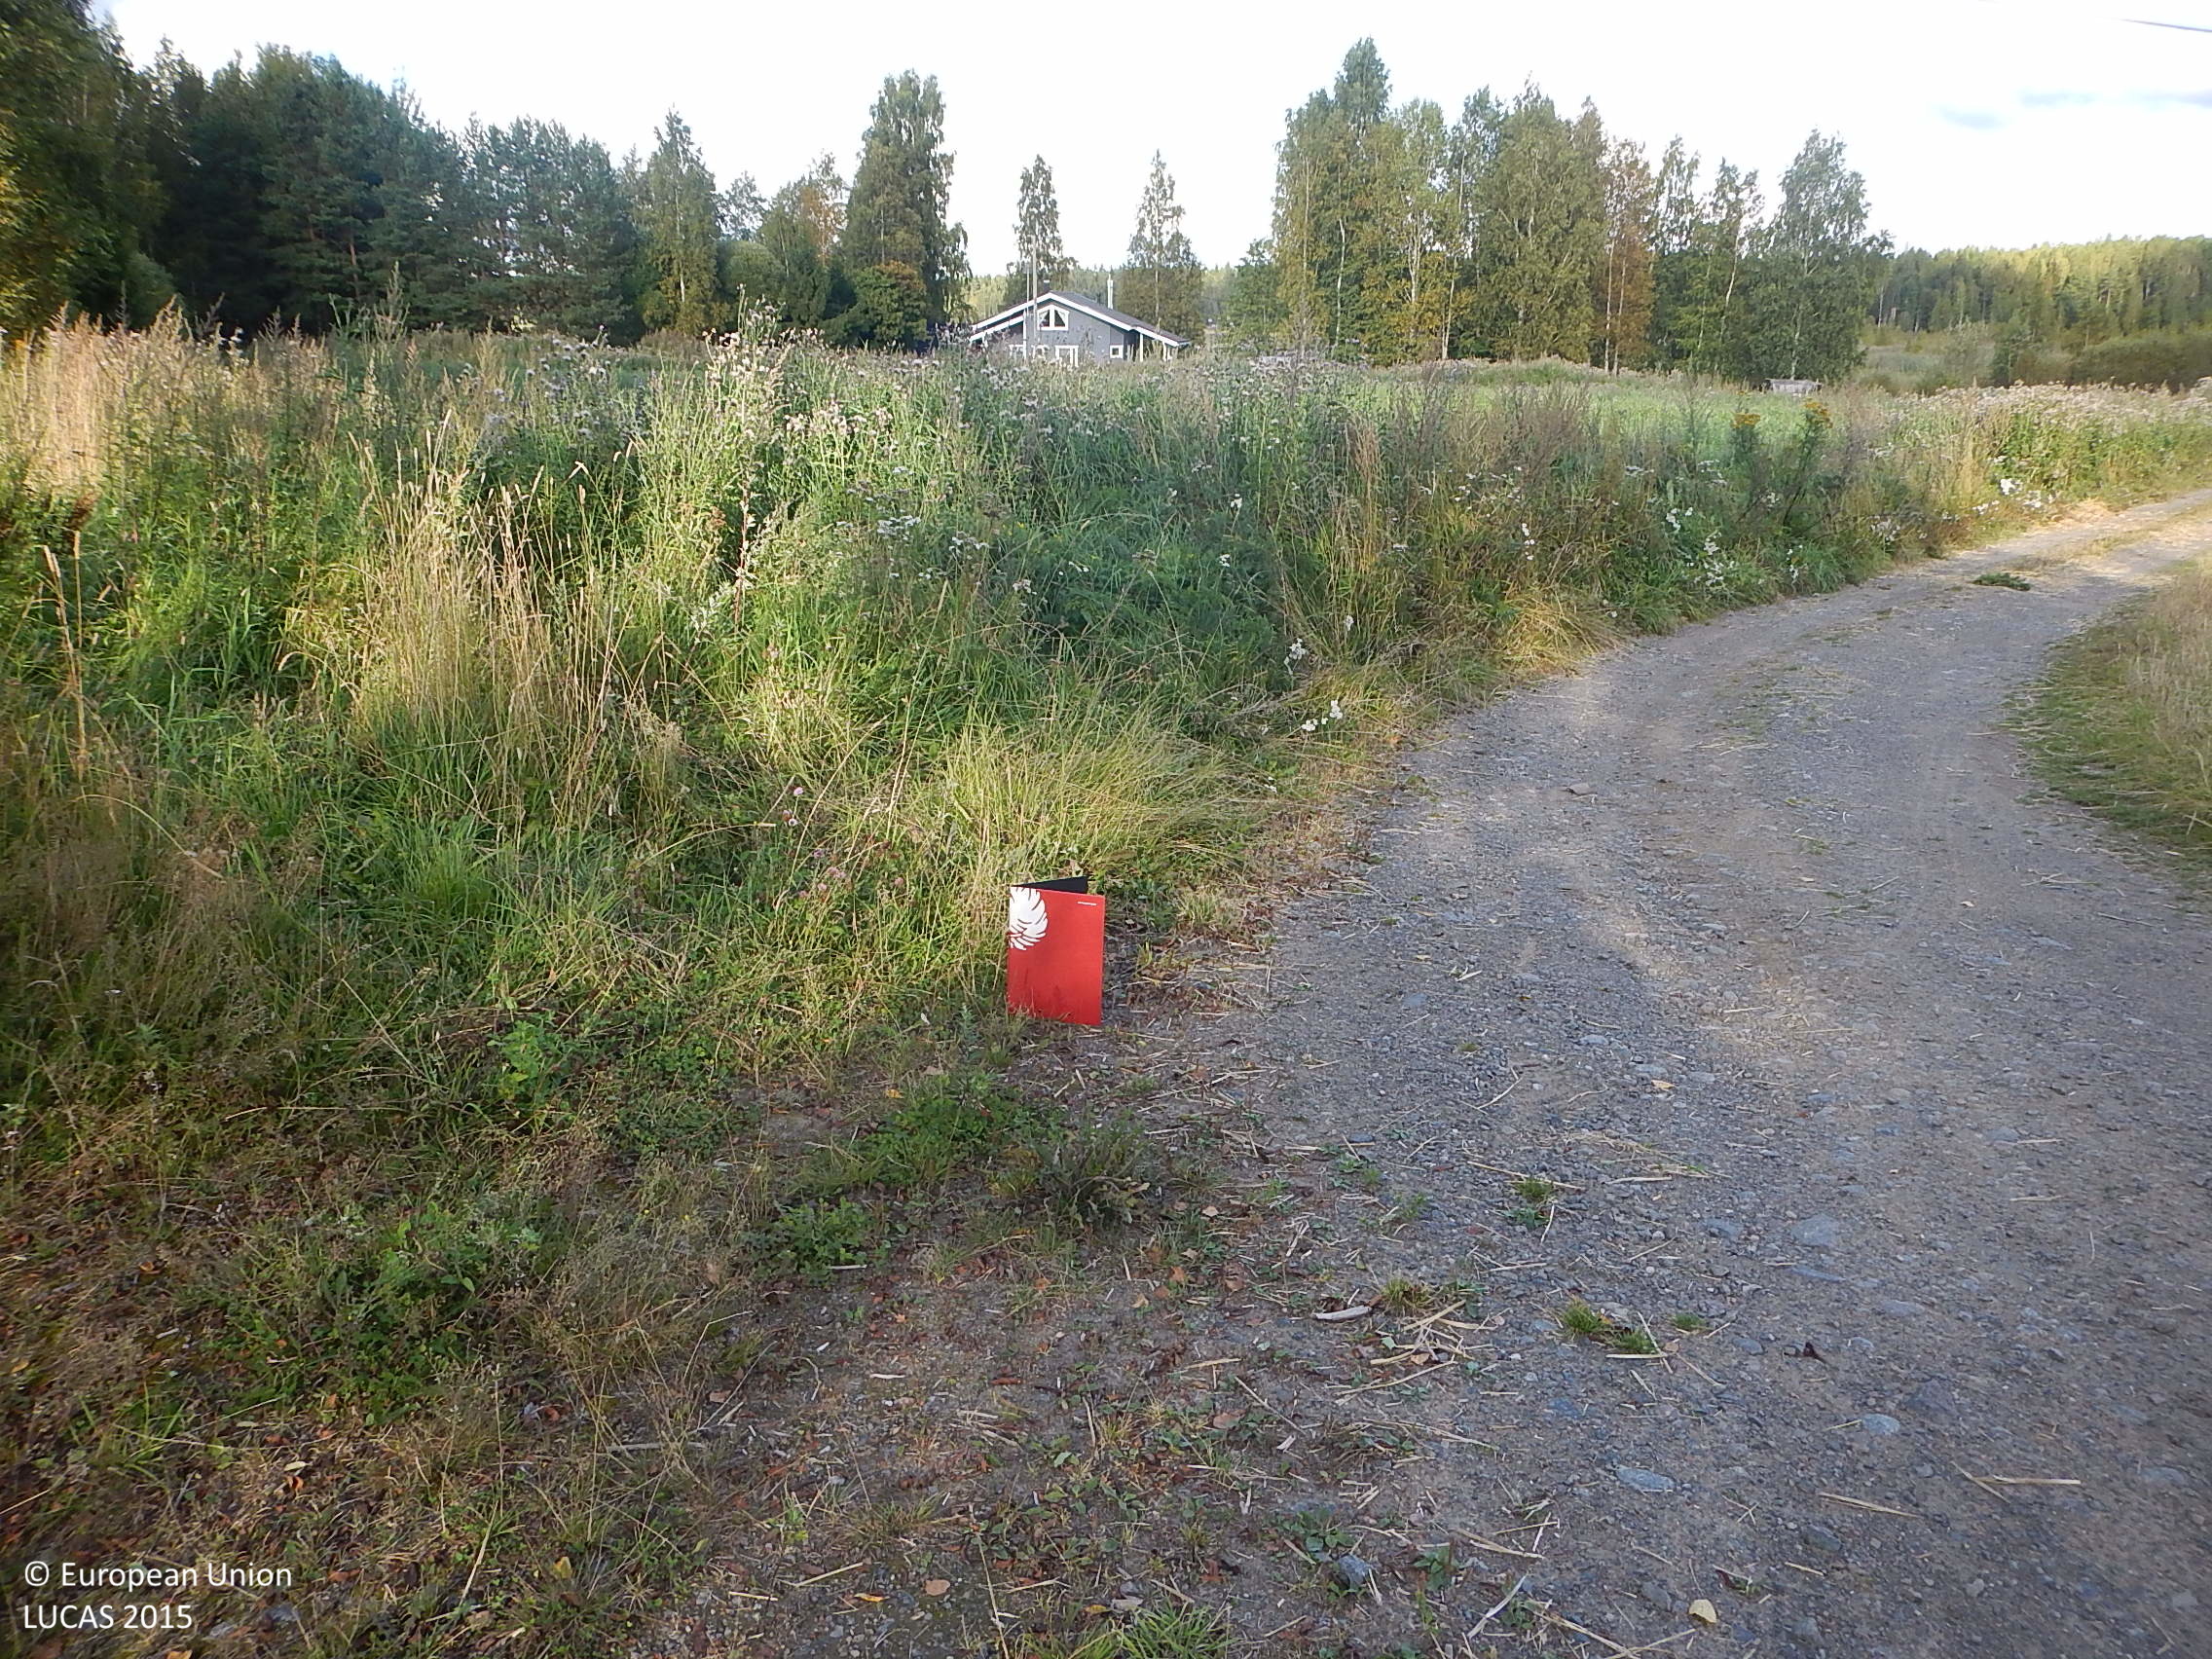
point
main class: Grassland
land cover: Spontaneously vegetated surfaces
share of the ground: > 75 %
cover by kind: herbaceous plants 100 %
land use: Fallow land
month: September
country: FI
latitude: 61.5011
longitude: 22.1006
